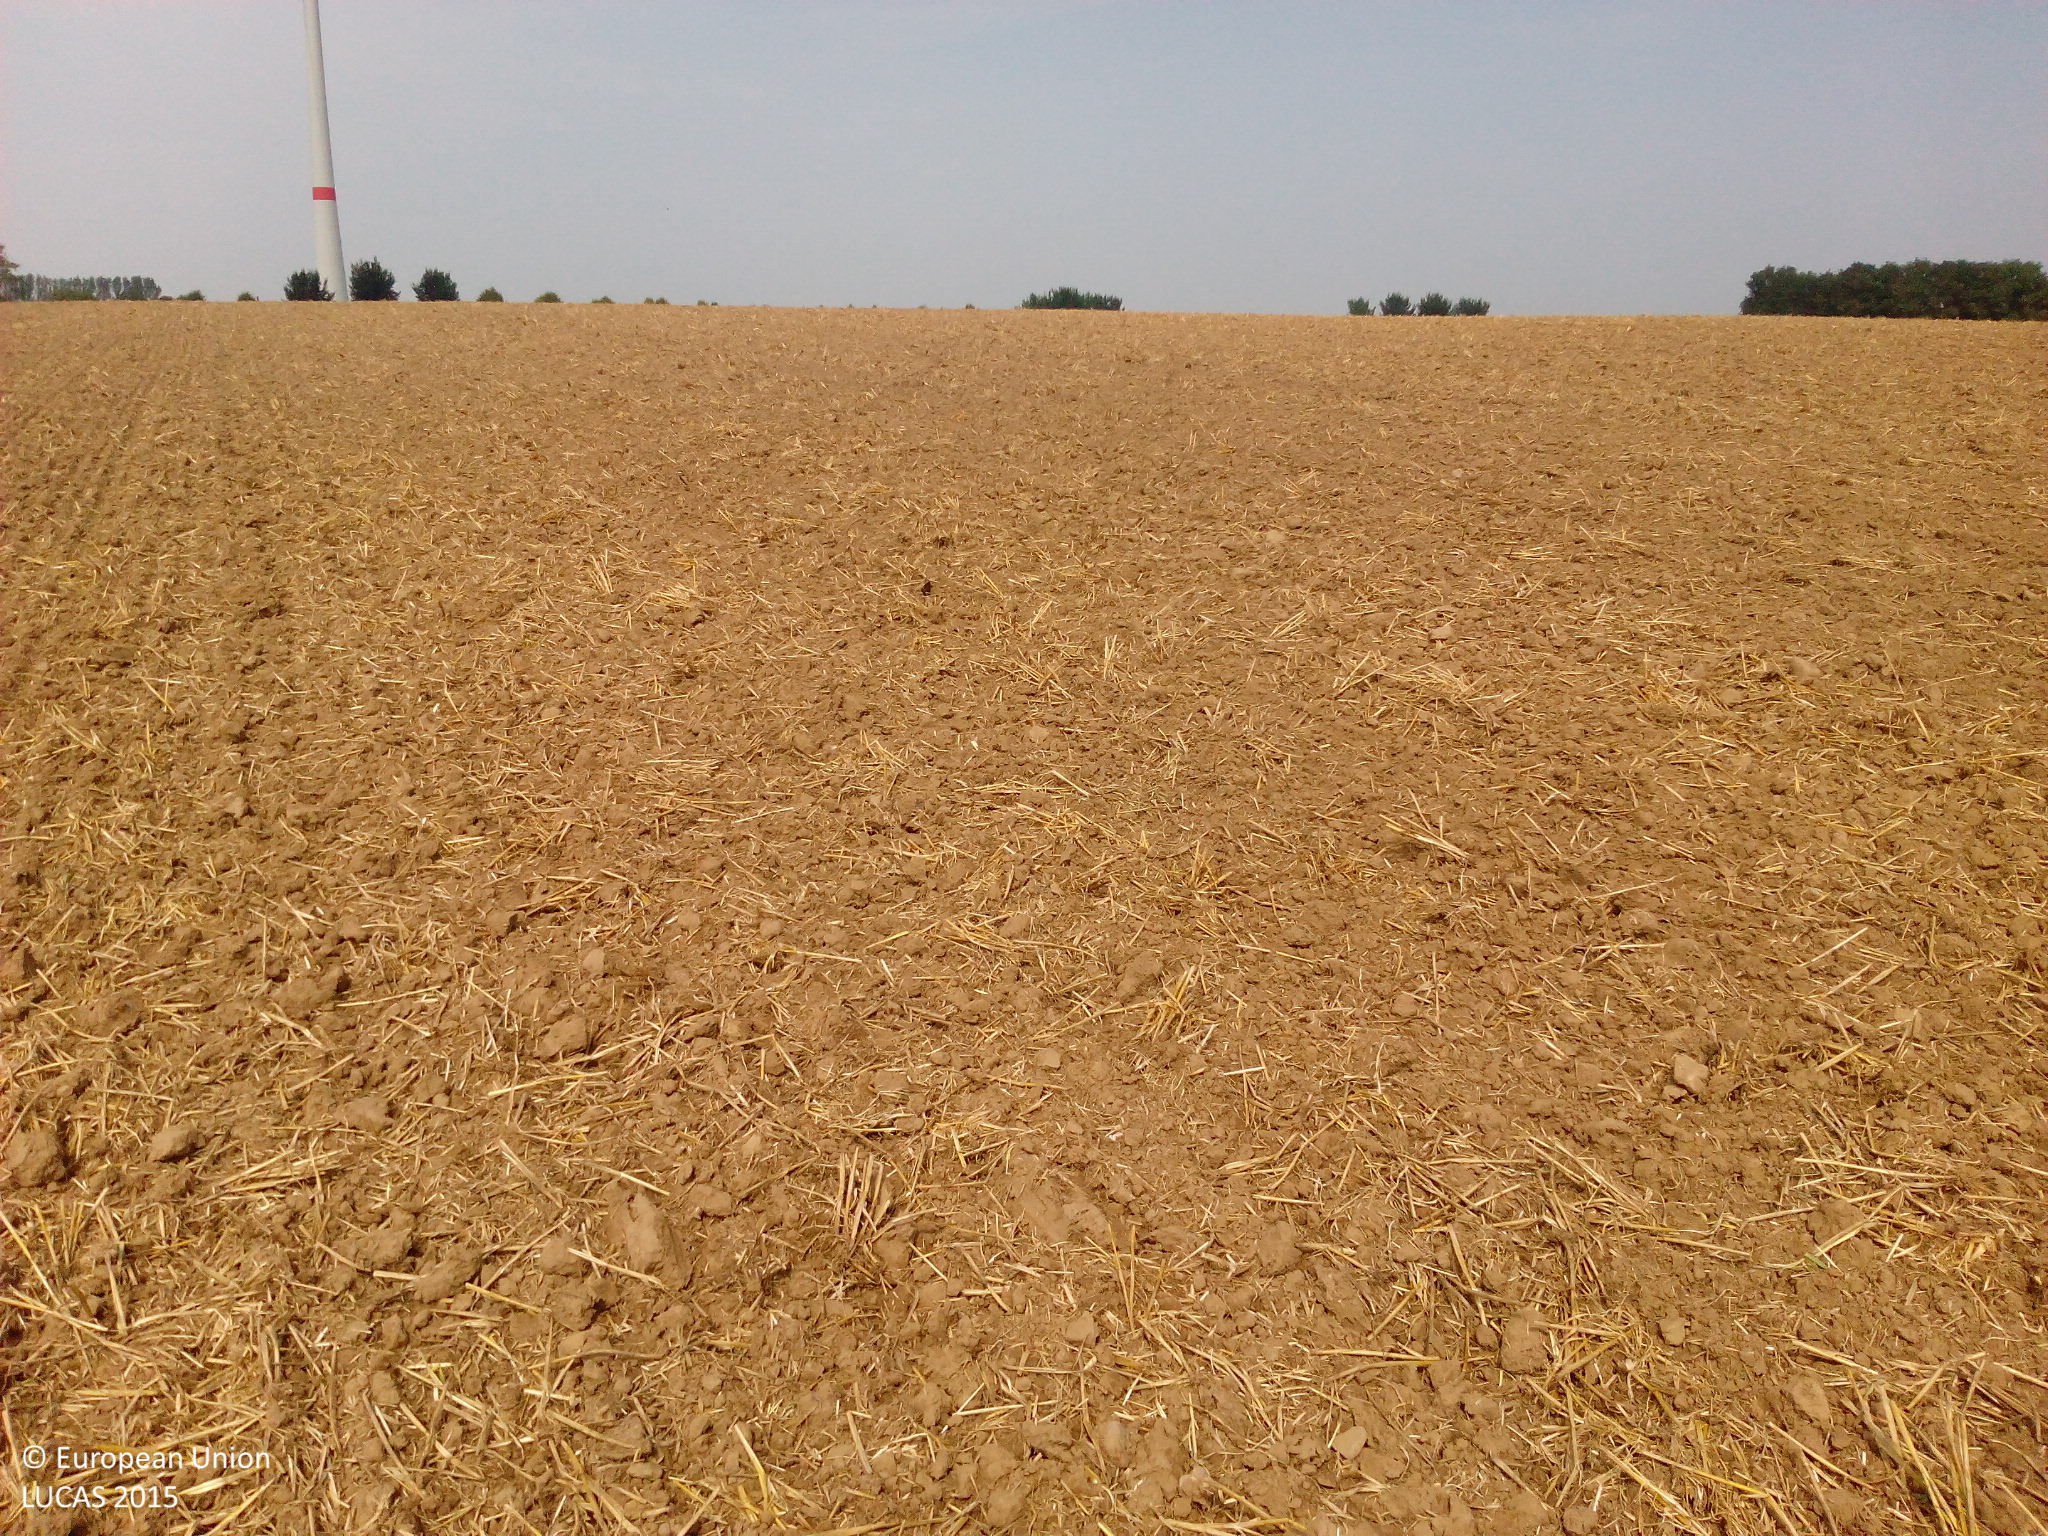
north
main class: Cropland
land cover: Rye
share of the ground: < 10 %
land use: Agriculture (excluding fallow land and kitchen gardens)
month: August
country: DE
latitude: 53.8292
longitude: 12.3238
